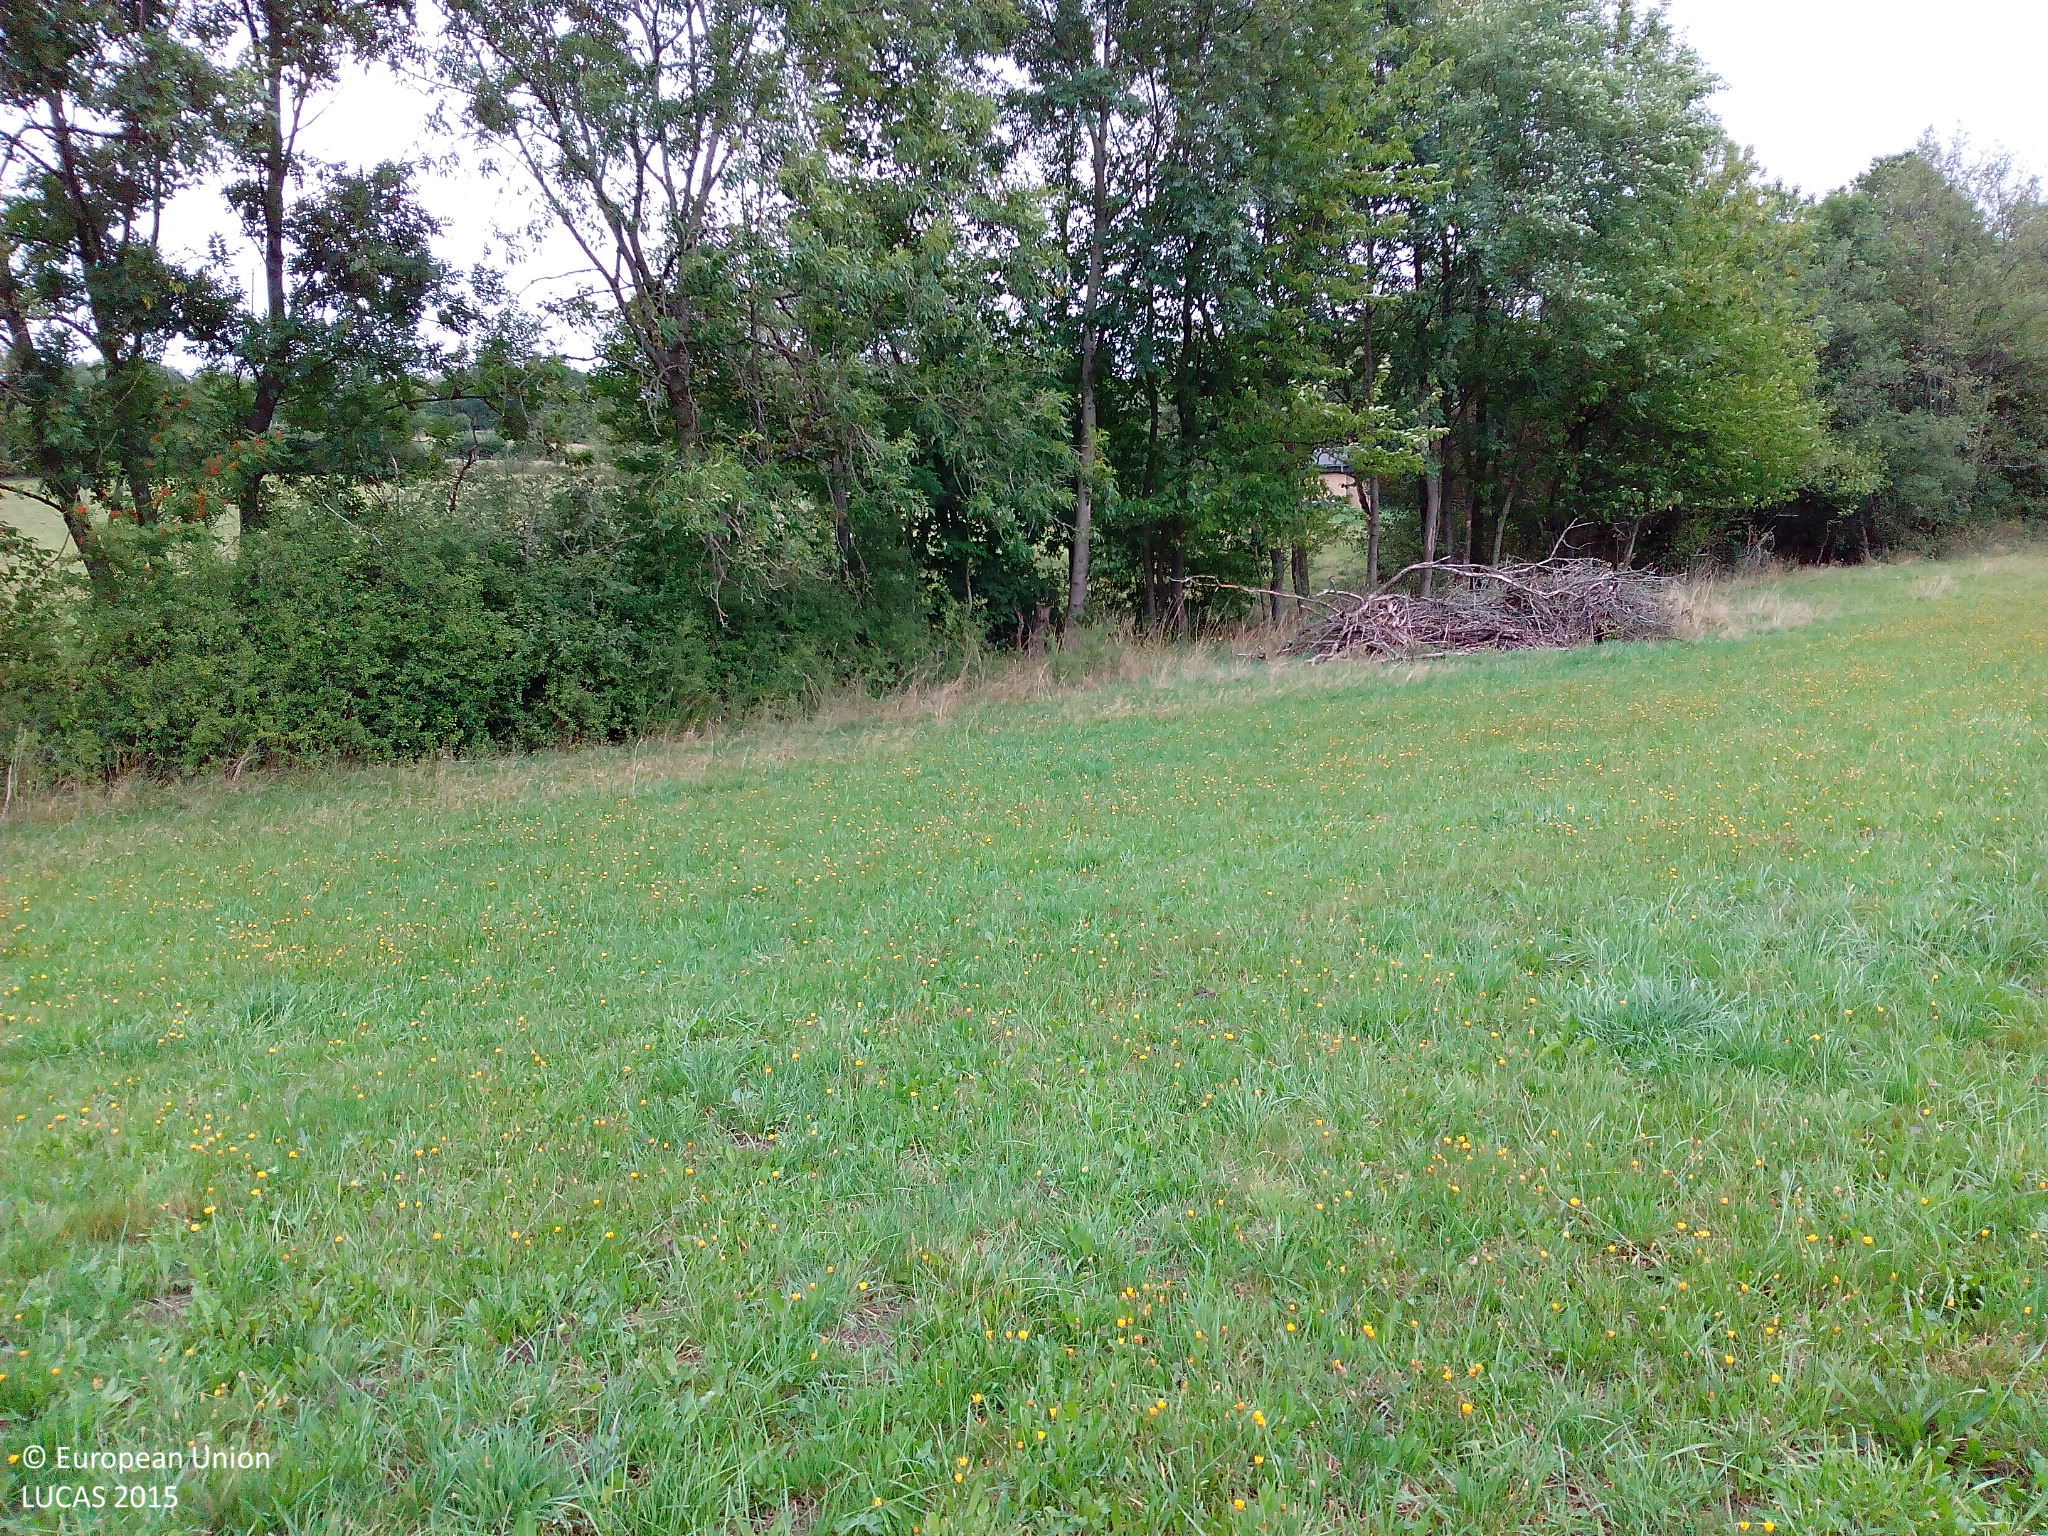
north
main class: Grassland
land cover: Grassland without tree/shrub cover
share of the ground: > 75 %
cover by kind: herbaceous plants 100 %
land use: Agriculture (excluding fallow land and kitchen gardens)
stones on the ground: < 10 %
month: August
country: DE
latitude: 50.4689
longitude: 9.1690
